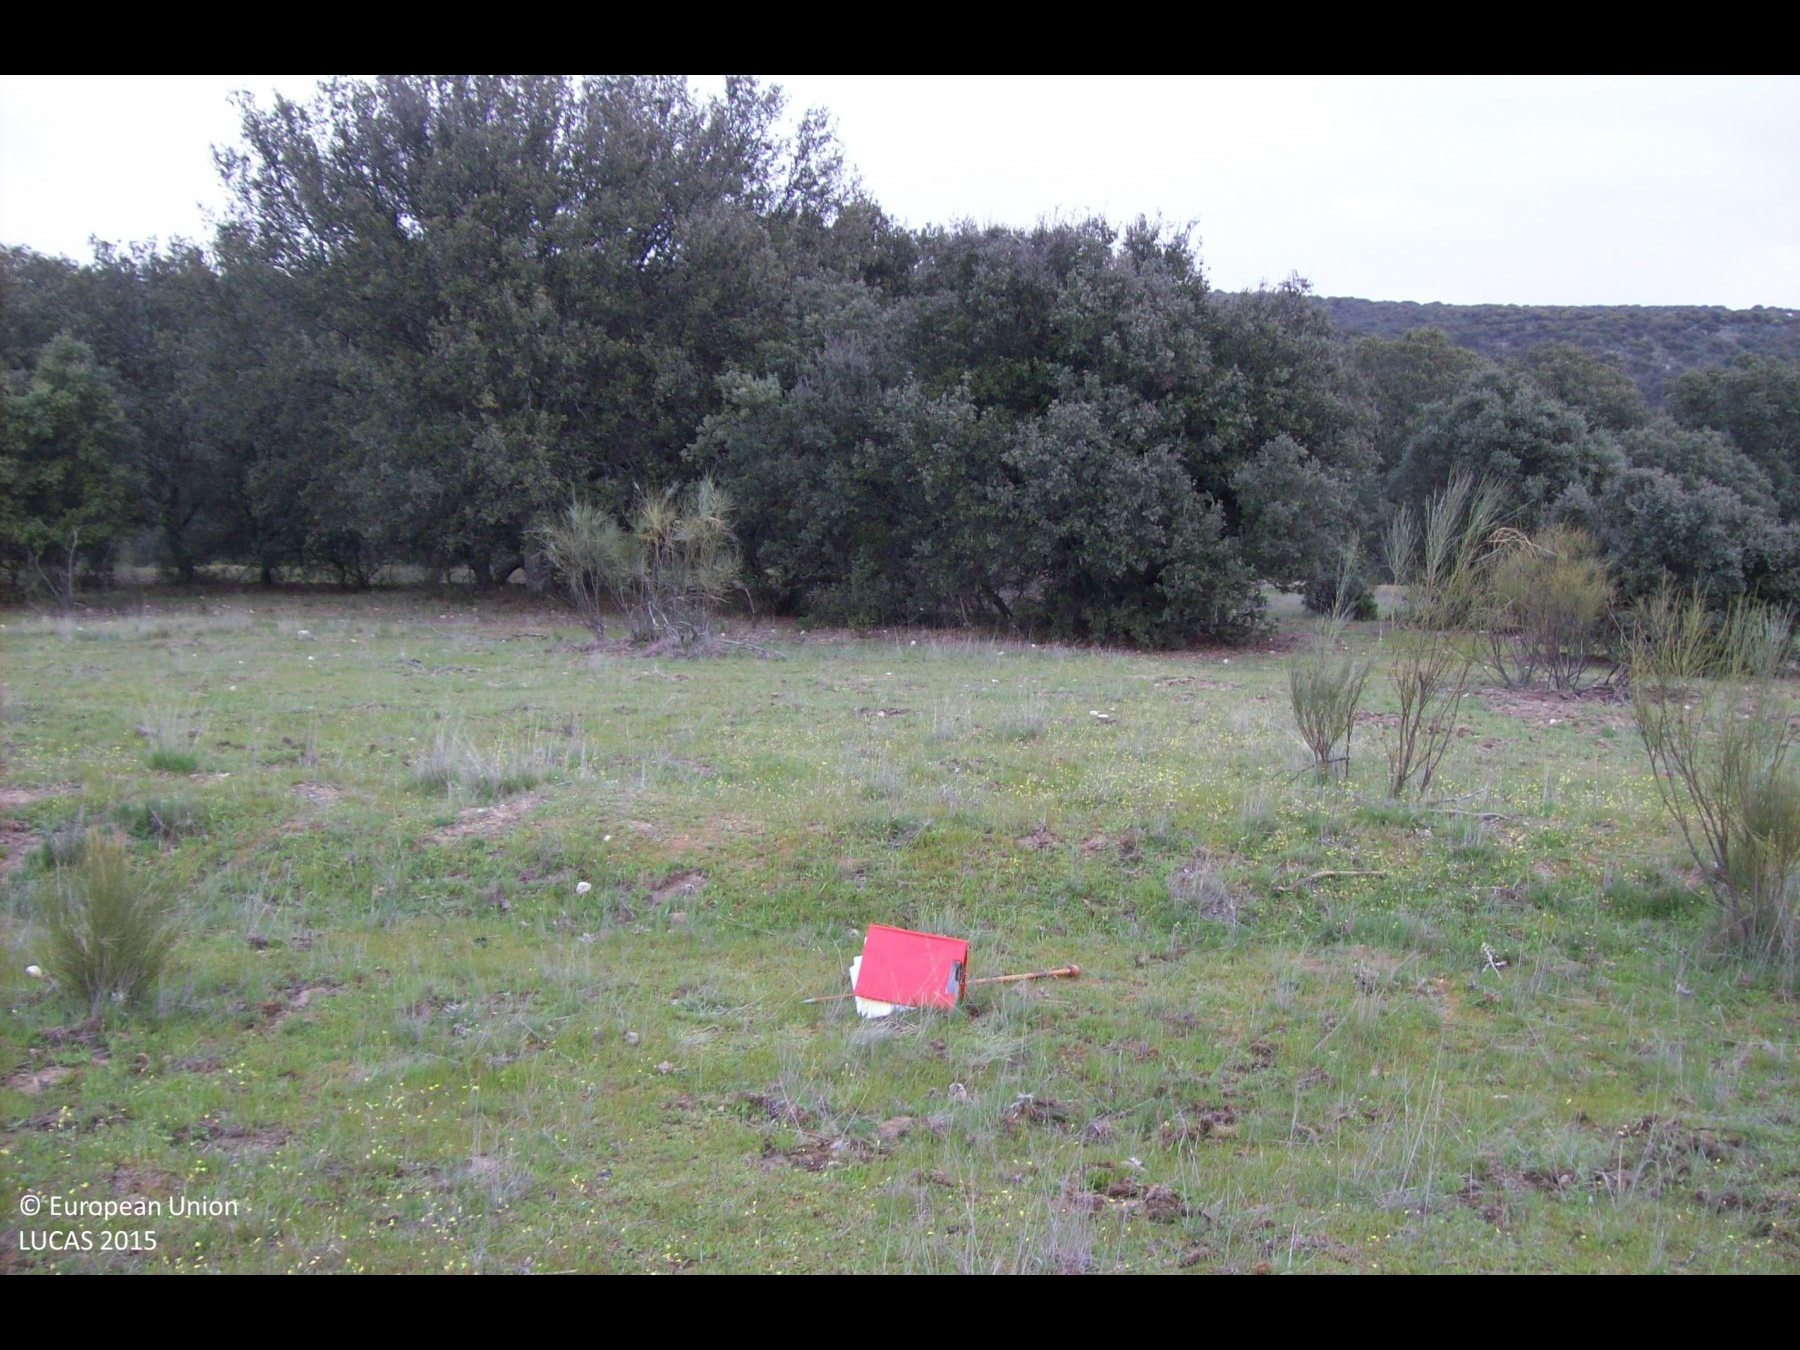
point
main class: Grassland
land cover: Grassland with sparse tree/shrub cover
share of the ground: > 75 %
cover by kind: herbaceous plants 85 %, broadleaved forest trees 5 %, shrubs 5 %
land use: Semi-natural and natural areas not in use
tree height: < 5 m
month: April
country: ES
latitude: 40.5415
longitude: -3.8675
